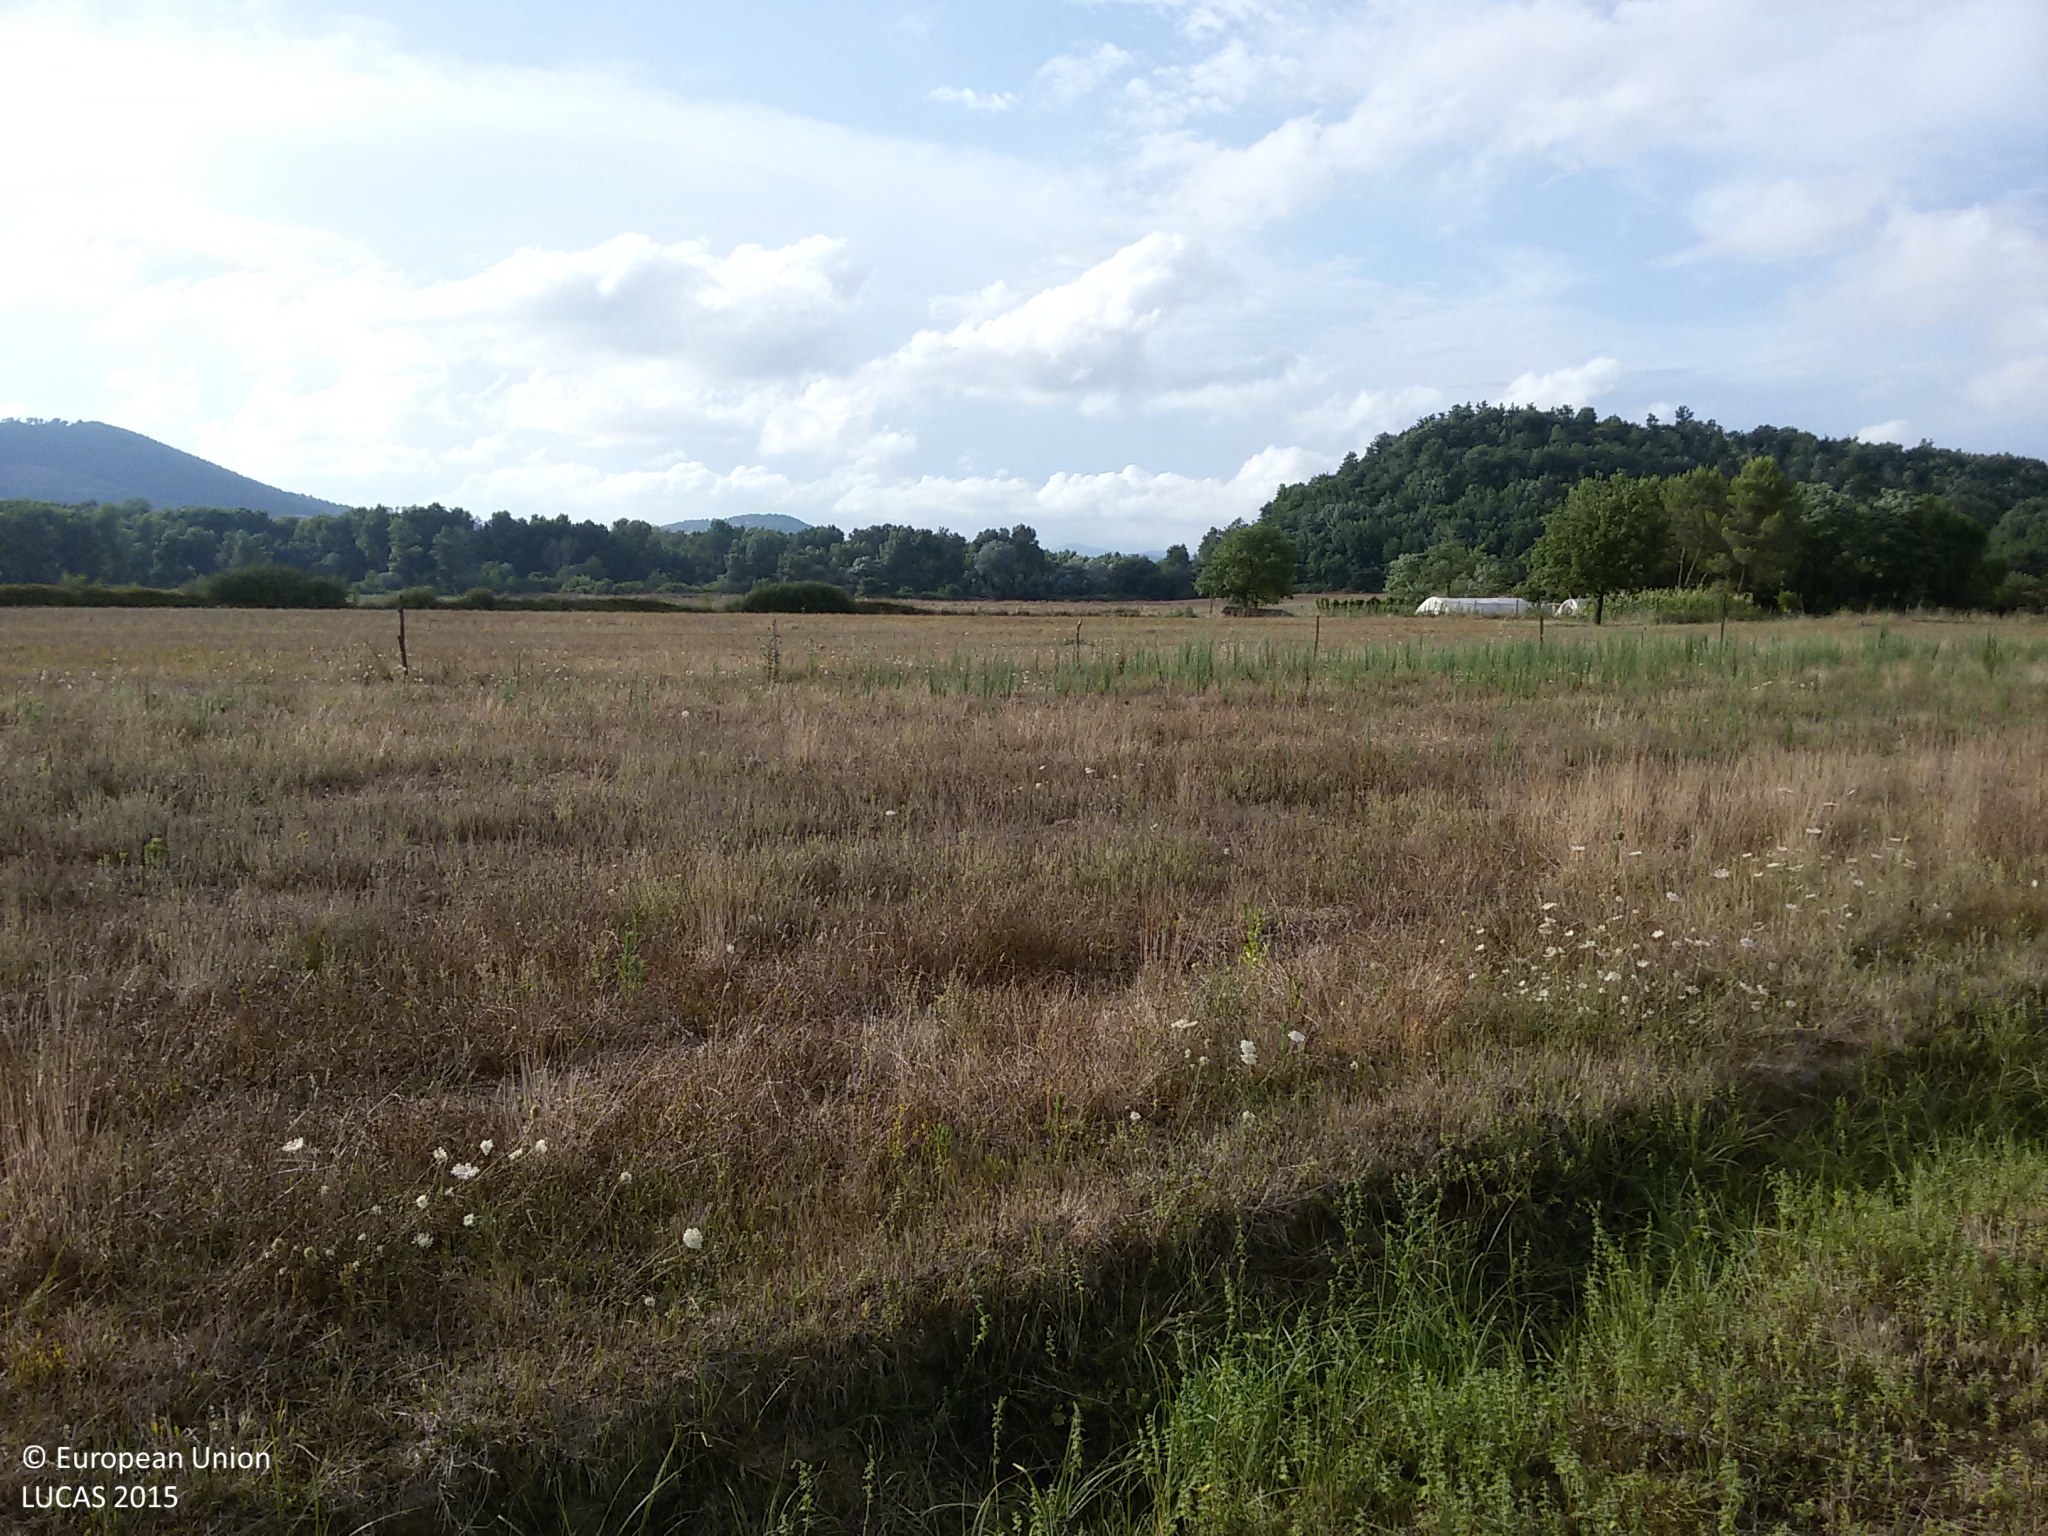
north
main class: Grassland
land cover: Grassland without tree/shrub cover
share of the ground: > 75 %
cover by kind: herbaceous plants 95 %, unconsolidated bare surface 5 %
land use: Agriculture (excluding fallow land and kitchen gardens)
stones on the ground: < 10 %
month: August
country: IT
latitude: 42.6054
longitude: 11.5914
